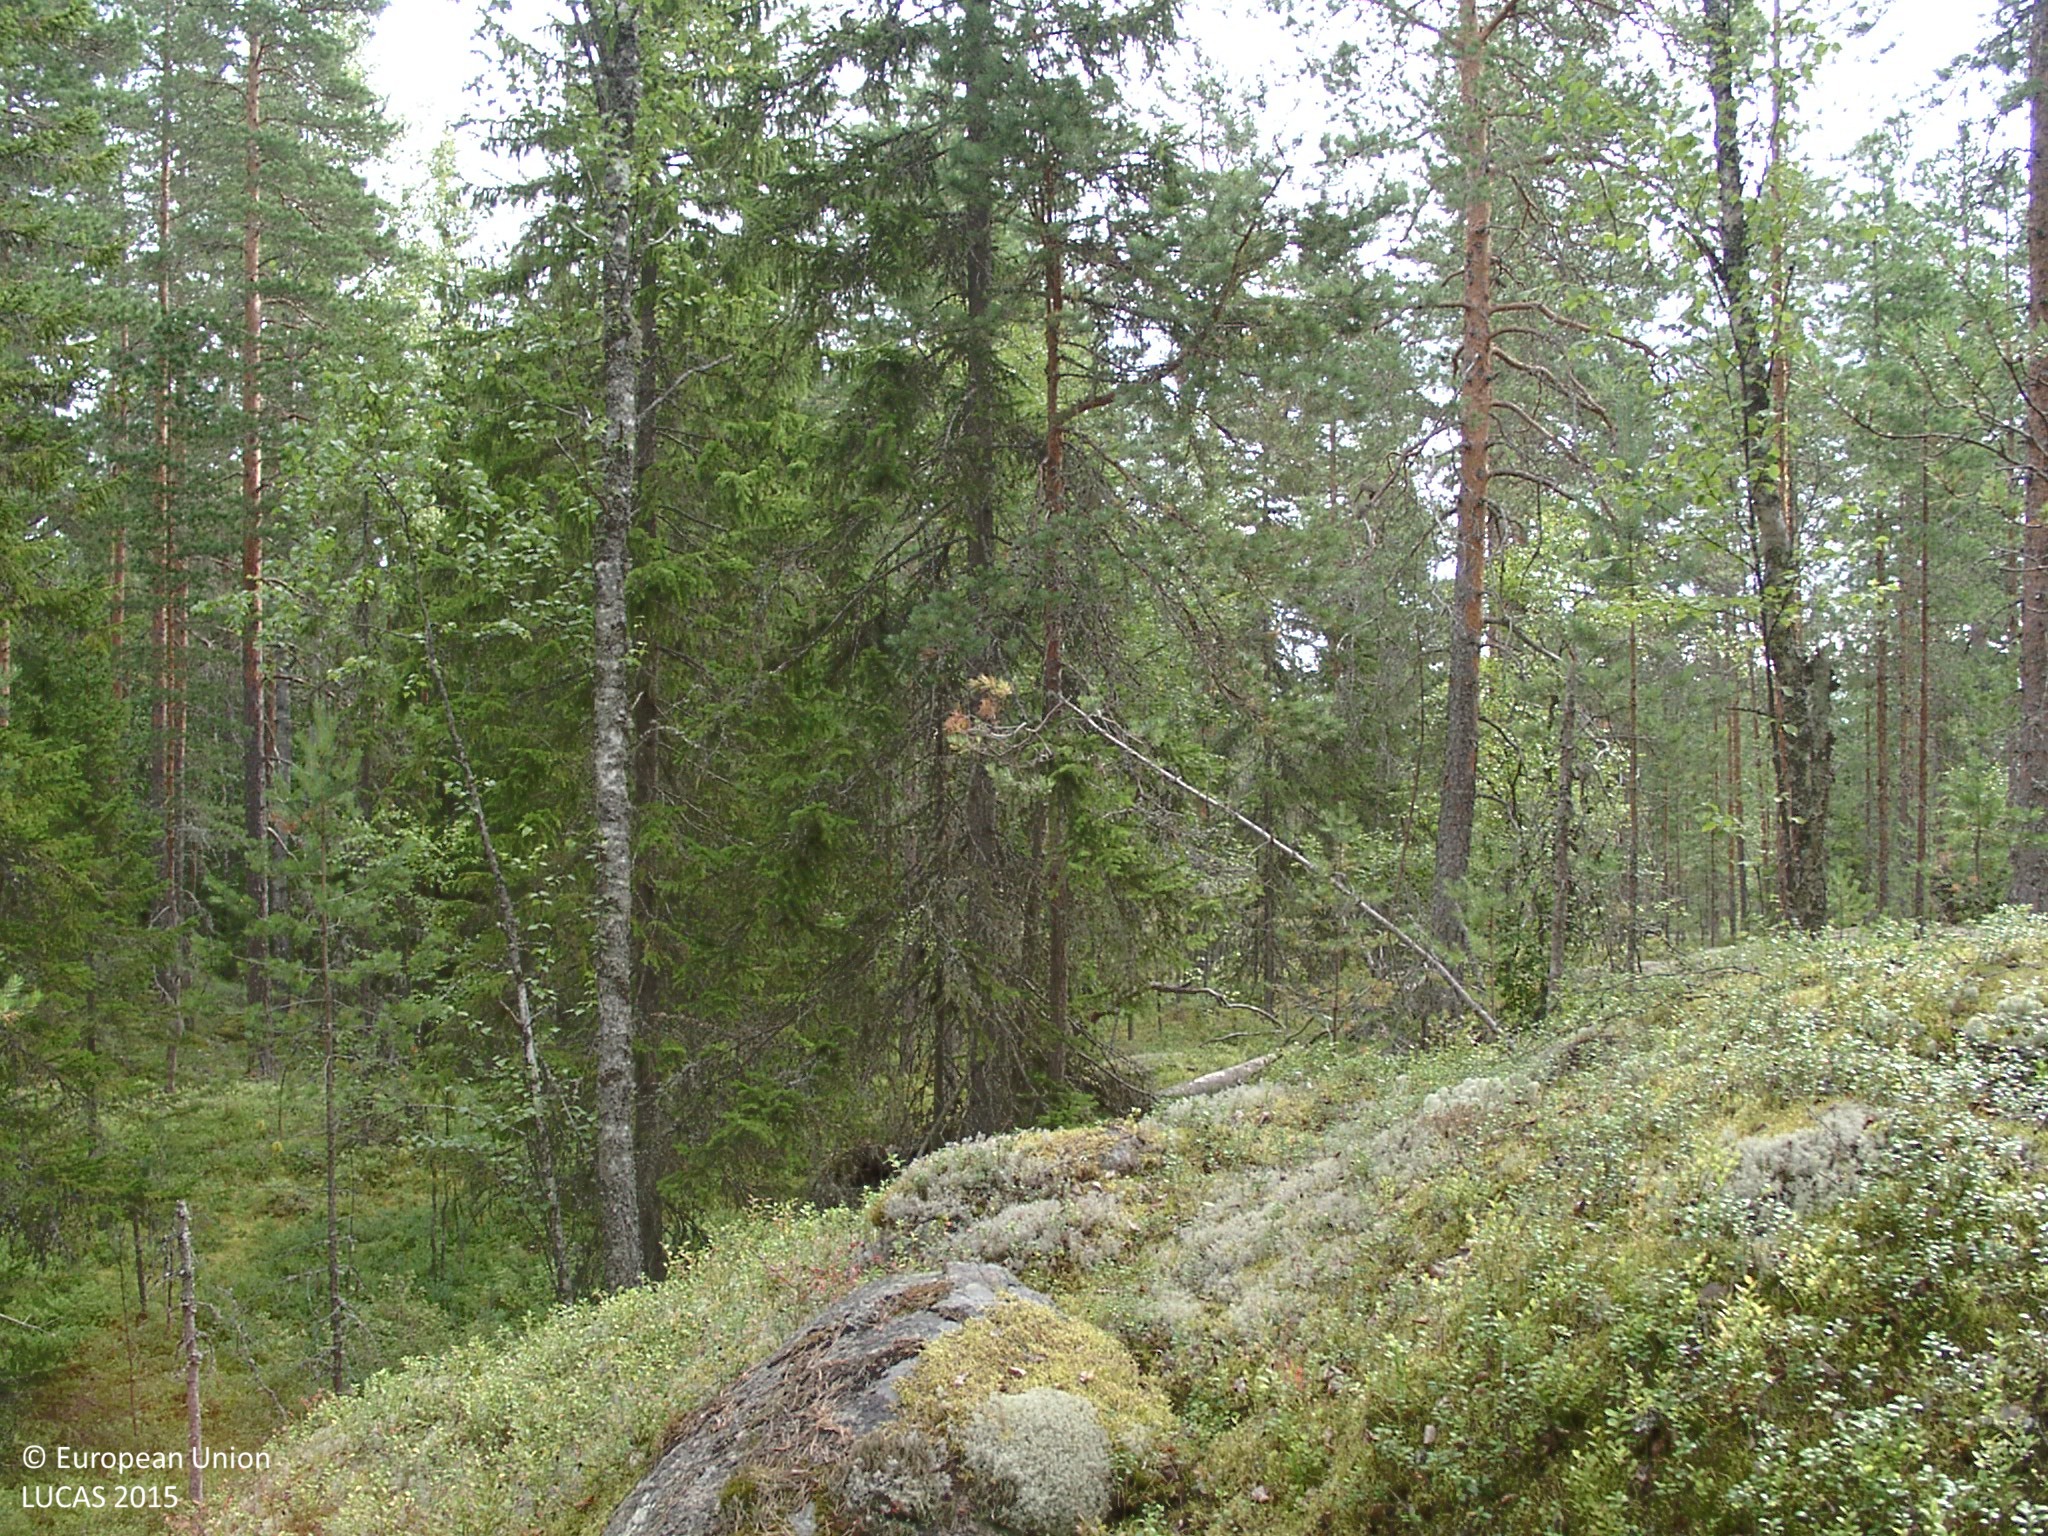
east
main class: Woodland
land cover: Other mixed woodland
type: boreal forest
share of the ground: 50 - 75 %
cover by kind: coniferous forest trees 40 %, lichens and mosses 25 %, shrubs 20 %, broadleaved forest trees 15 %
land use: Forestry
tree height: > 5 m
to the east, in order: Other mixed woodland; Other coniferous woodland; Other mixed woodland; Pine dominated coniferous woodland; Shrubland without tree cover; Pine dominated coniferous woodland; Other coniferous woodland
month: August
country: FI
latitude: 61.8604
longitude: 25.2996
